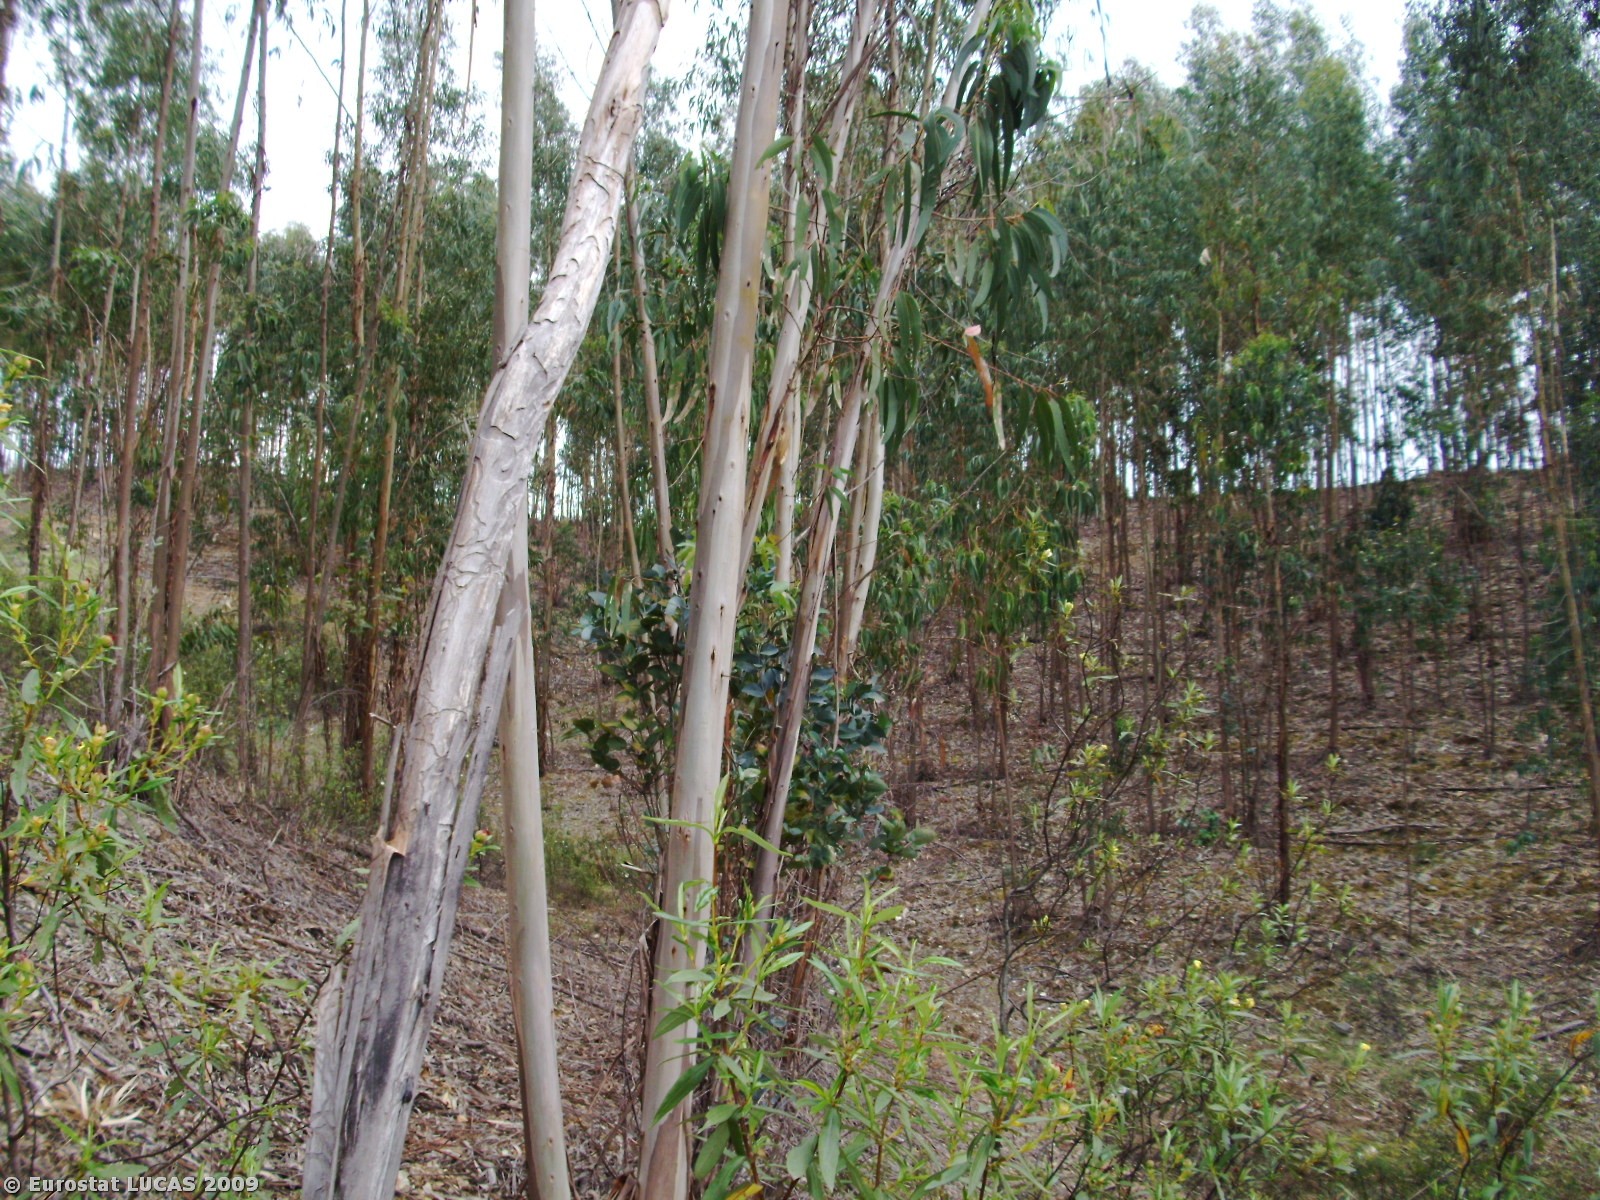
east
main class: Woodland
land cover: Broadleaved woodland
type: plantations and self-sown exotic forest
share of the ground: > 75 %
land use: Forestry
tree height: > 5 m
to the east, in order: Broadleaved woodland; Spontaneously vegetated surfaces; Rivers and streams; Spontaneously vegetated surfaces; Broadleaved woodland; Tracks; Coniferous woodland; Tracks; Shrubland with sparse tree cover
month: April
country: PT
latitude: 39.7648
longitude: -7.5271
